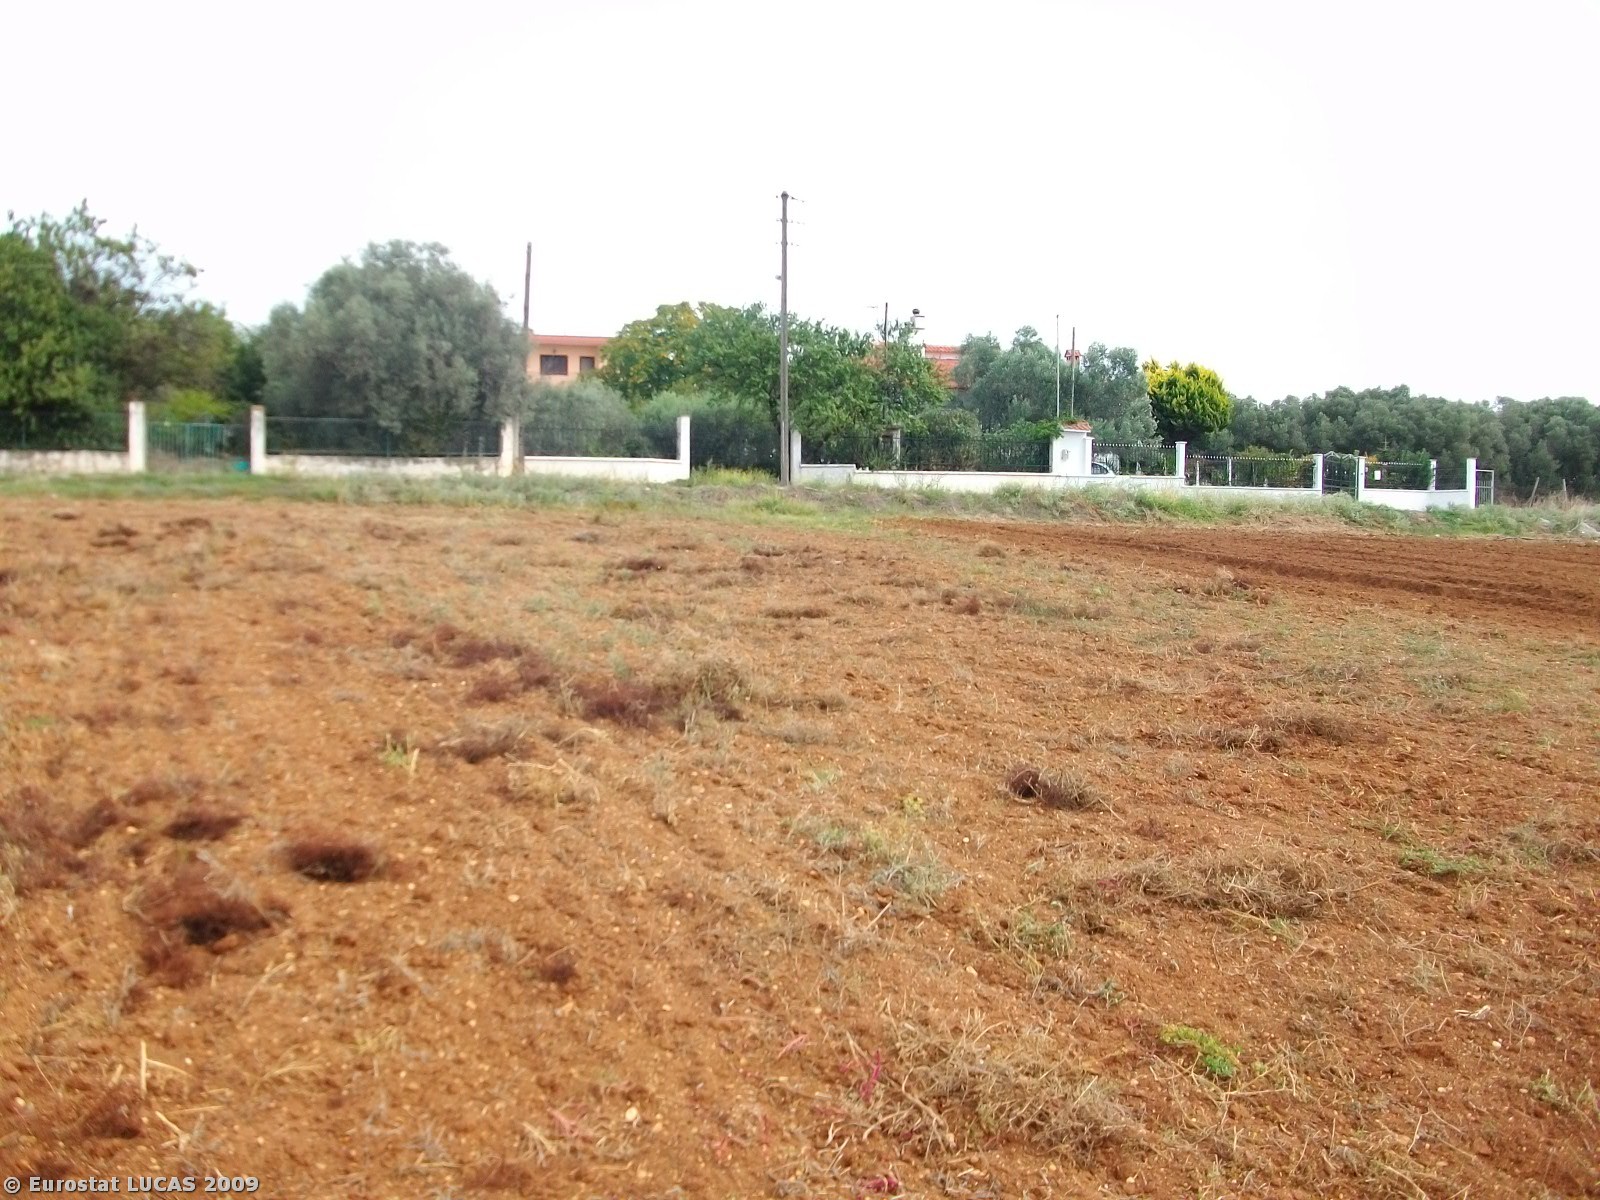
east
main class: Cropland
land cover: Common wheat
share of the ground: < 10 %
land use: Agriculture (excluding fallow land and kitchen gardens)
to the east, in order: Common wheat; Grass margins; Paved roads, cycling and walking lanes; Grass margins; Fences; Electric lines; Broadleaved woodland; Artificial constructions in urban areas; Fences; Olive groves; Grassland with sparse tree/shrub cover; Fences; Artificial constructions in urban areas; Abandoned hedges; Fences; Grass margins; Paved roads, cycling and walking lanes; Grass margins
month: September
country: GR
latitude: 40.5002
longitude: 22.8307
